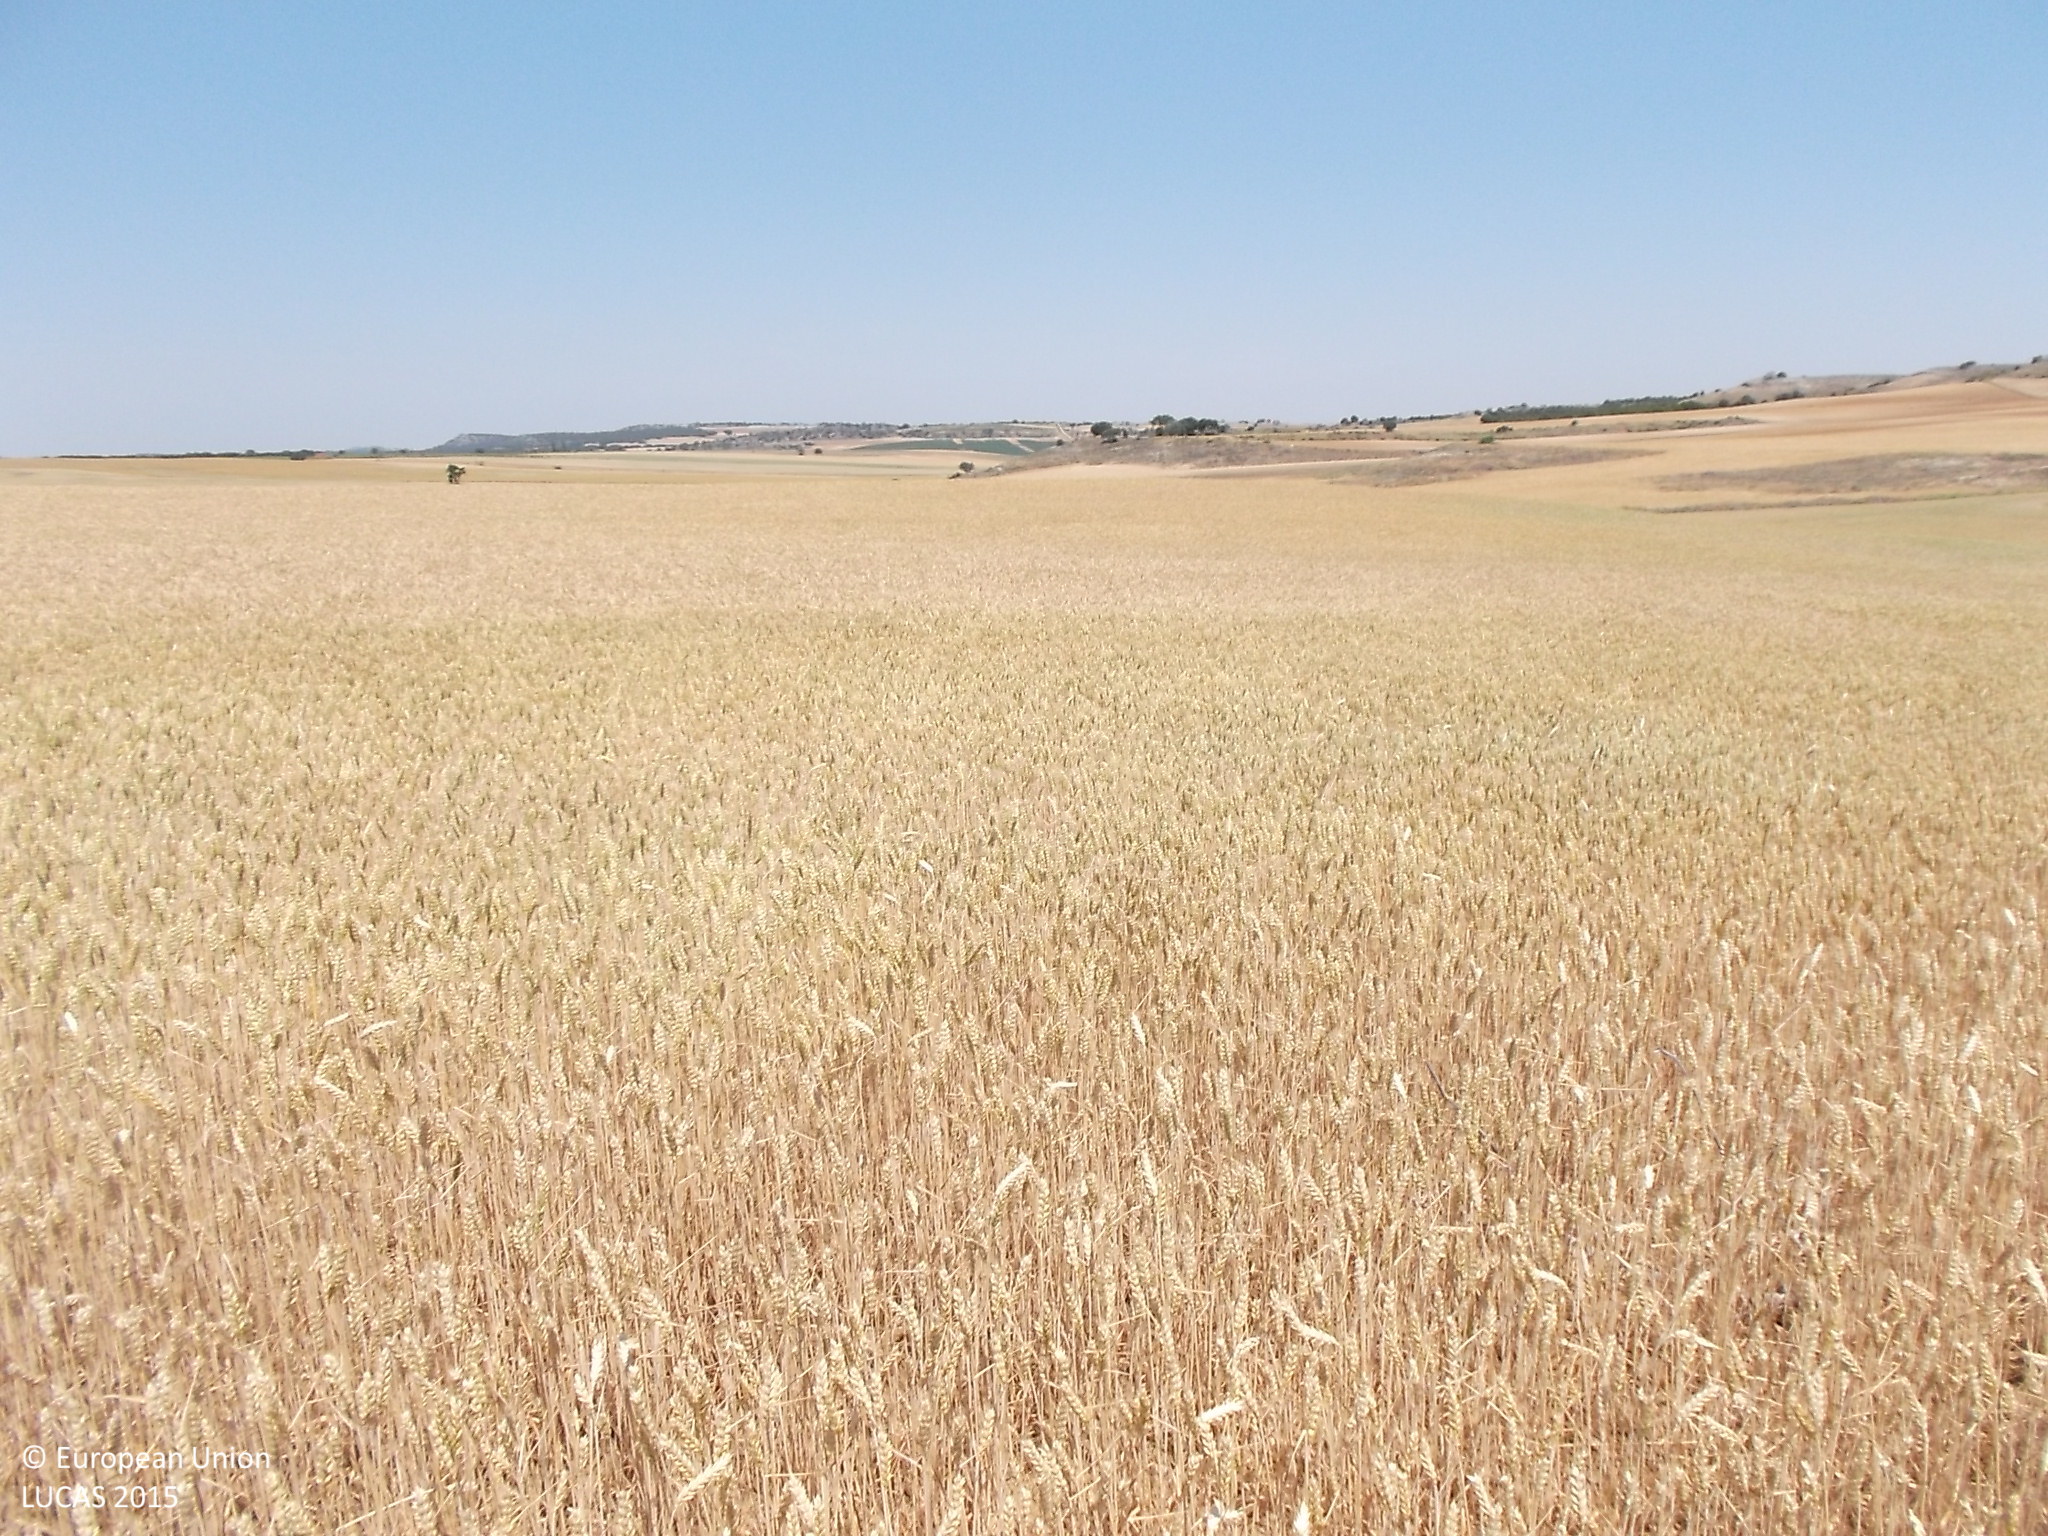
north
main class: Cropland
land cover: Common wheat
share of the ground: > 75 %
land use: Agriculture (excluding fallow land and kitchen gardens)
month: June
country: ES
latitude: 41.3485
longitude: -5.4604
